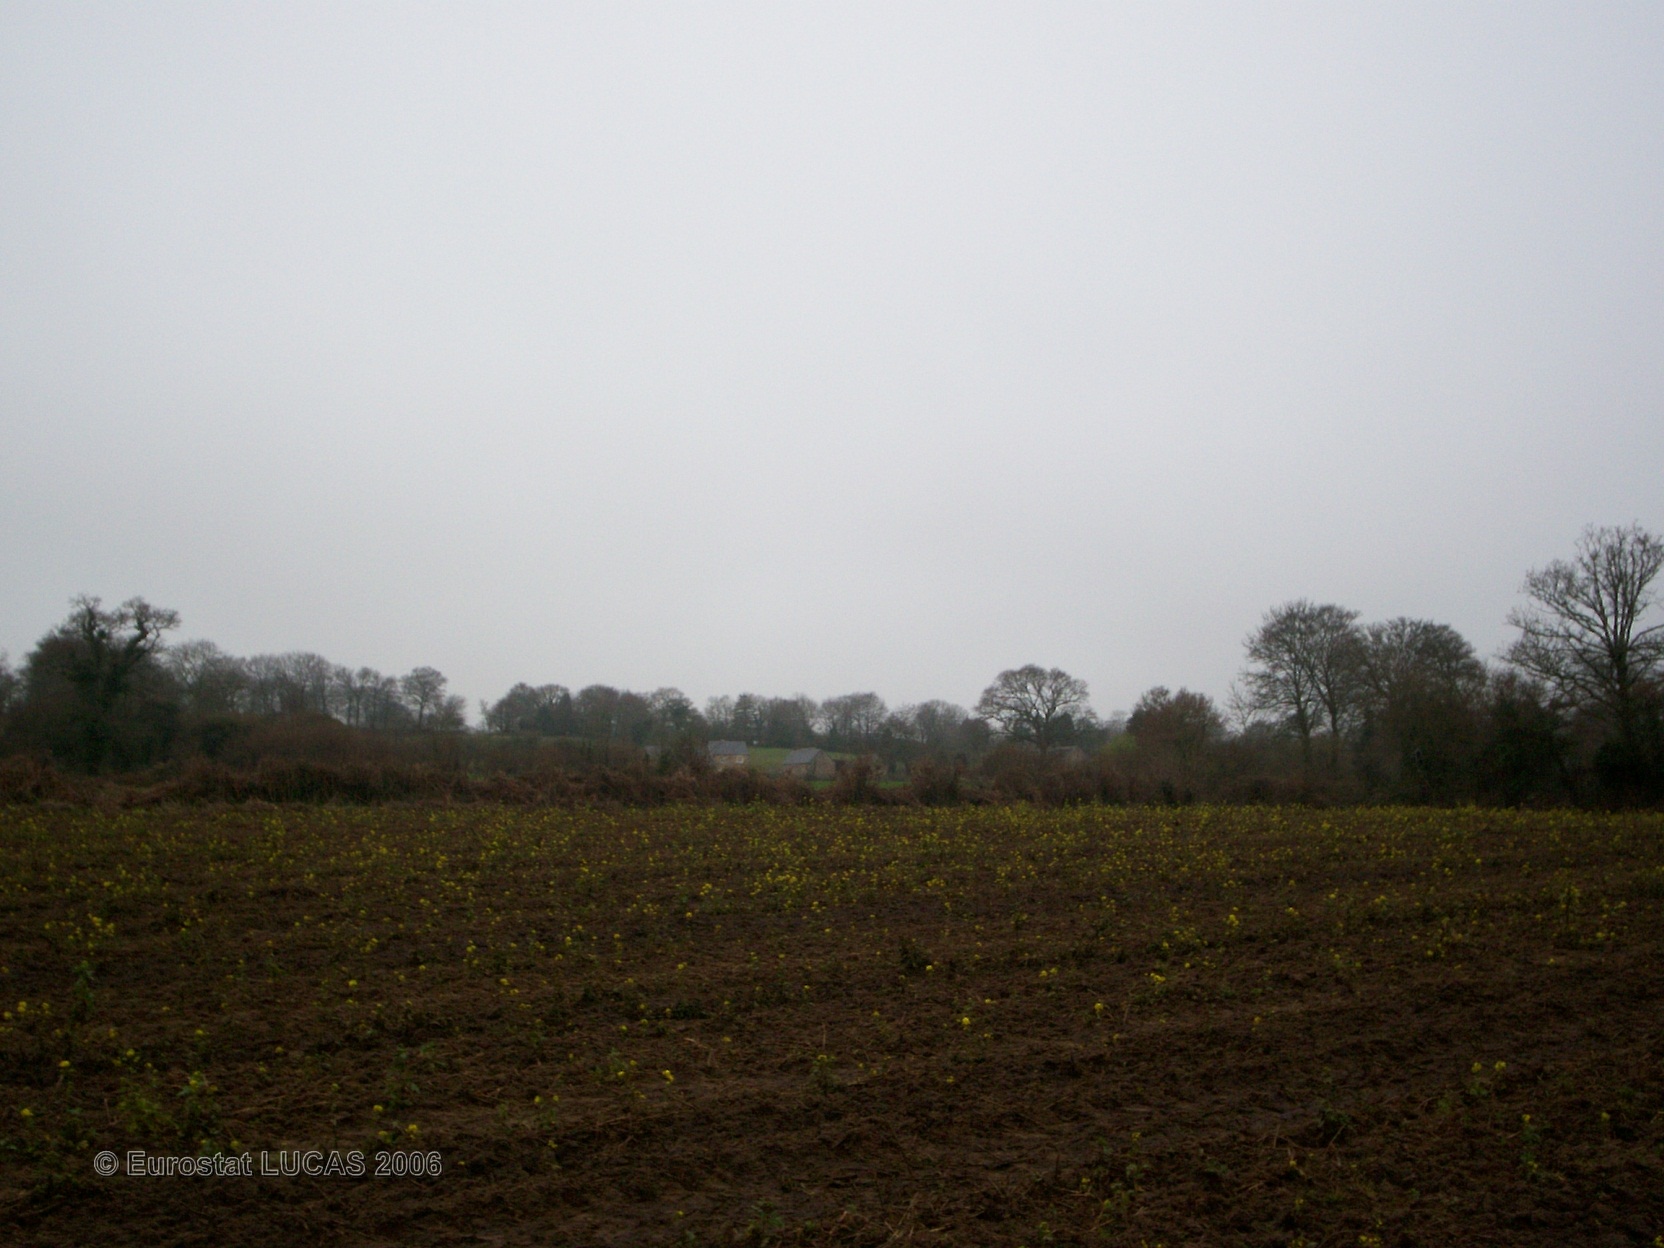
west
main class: Cropland
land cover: Maize
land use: Agriculture (excluding fallow land and kitchen gardens)
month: May
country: FR
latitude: 49.5159
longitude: -1.6120
